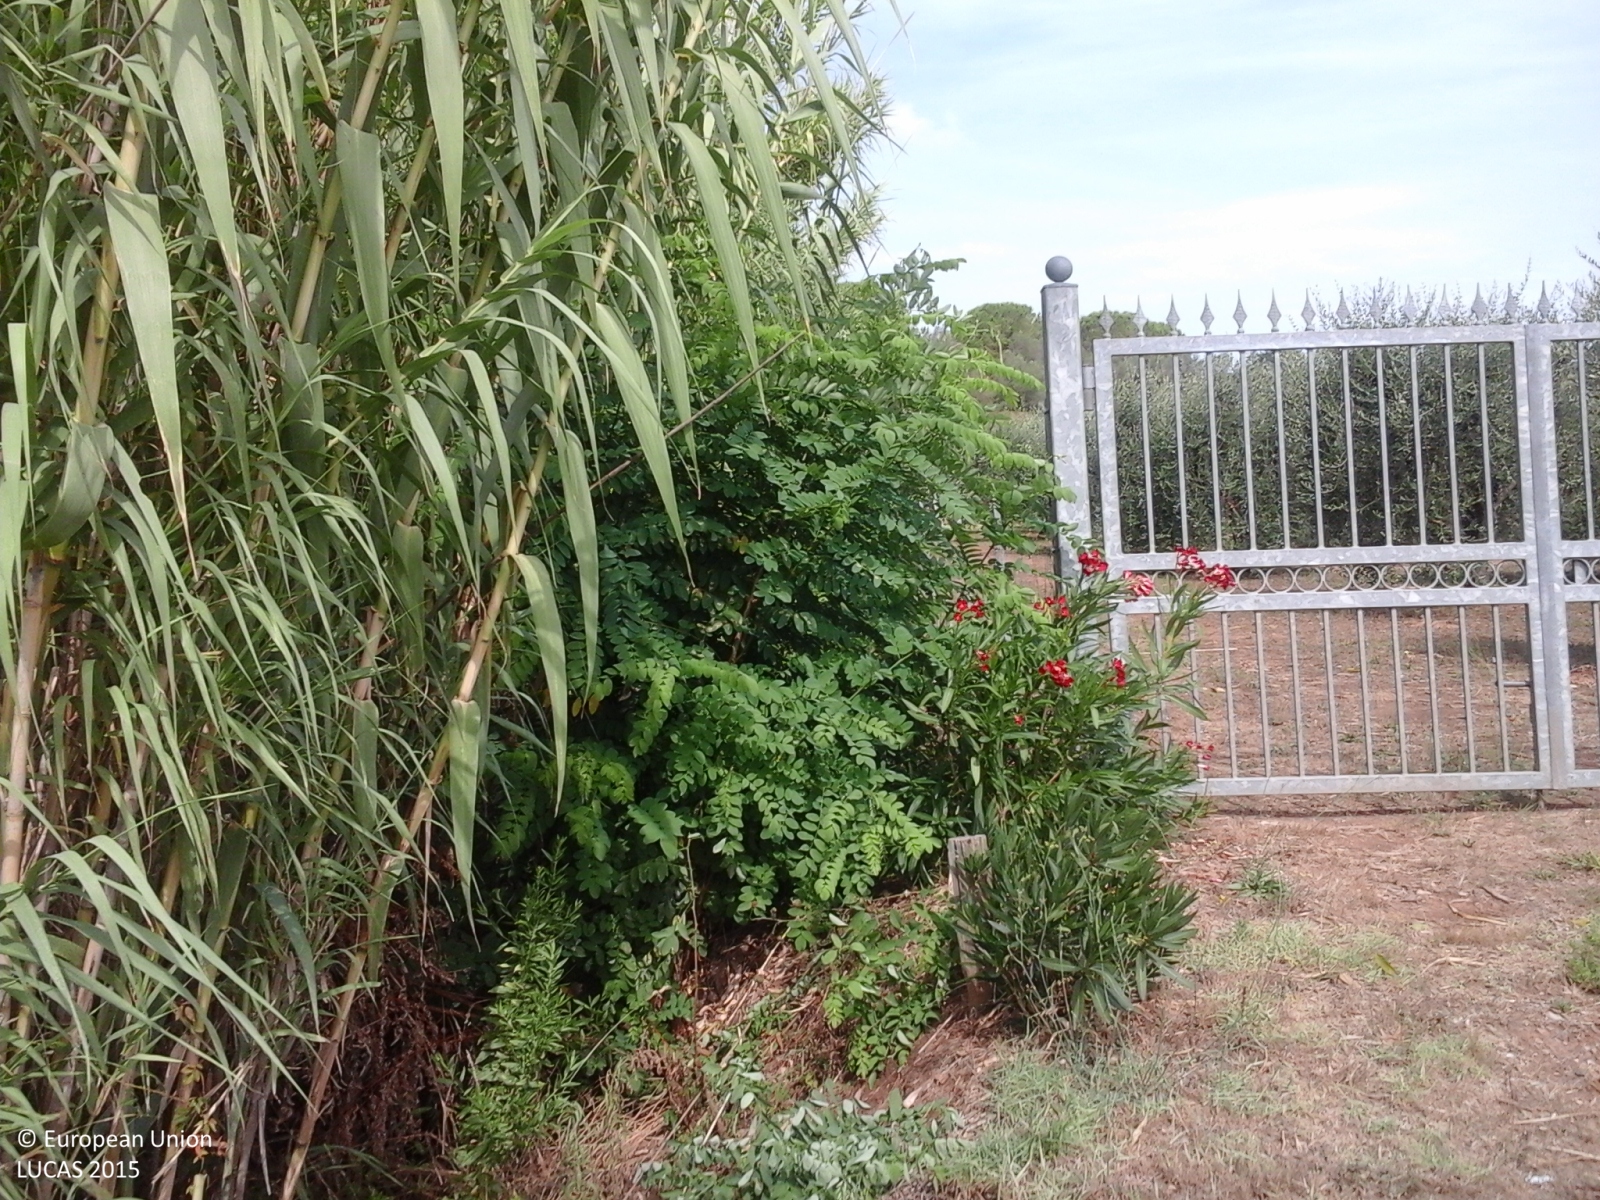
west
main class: Cropland
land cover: Olive groves
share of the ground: 50 - 75 %
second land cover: Grassland without tree/shrub cover
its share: 10 - 25 %
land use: Agriculture (excluding fallow land and kitchen gardens)
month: August
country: IT
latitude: 42.9386
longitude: 10.9406
